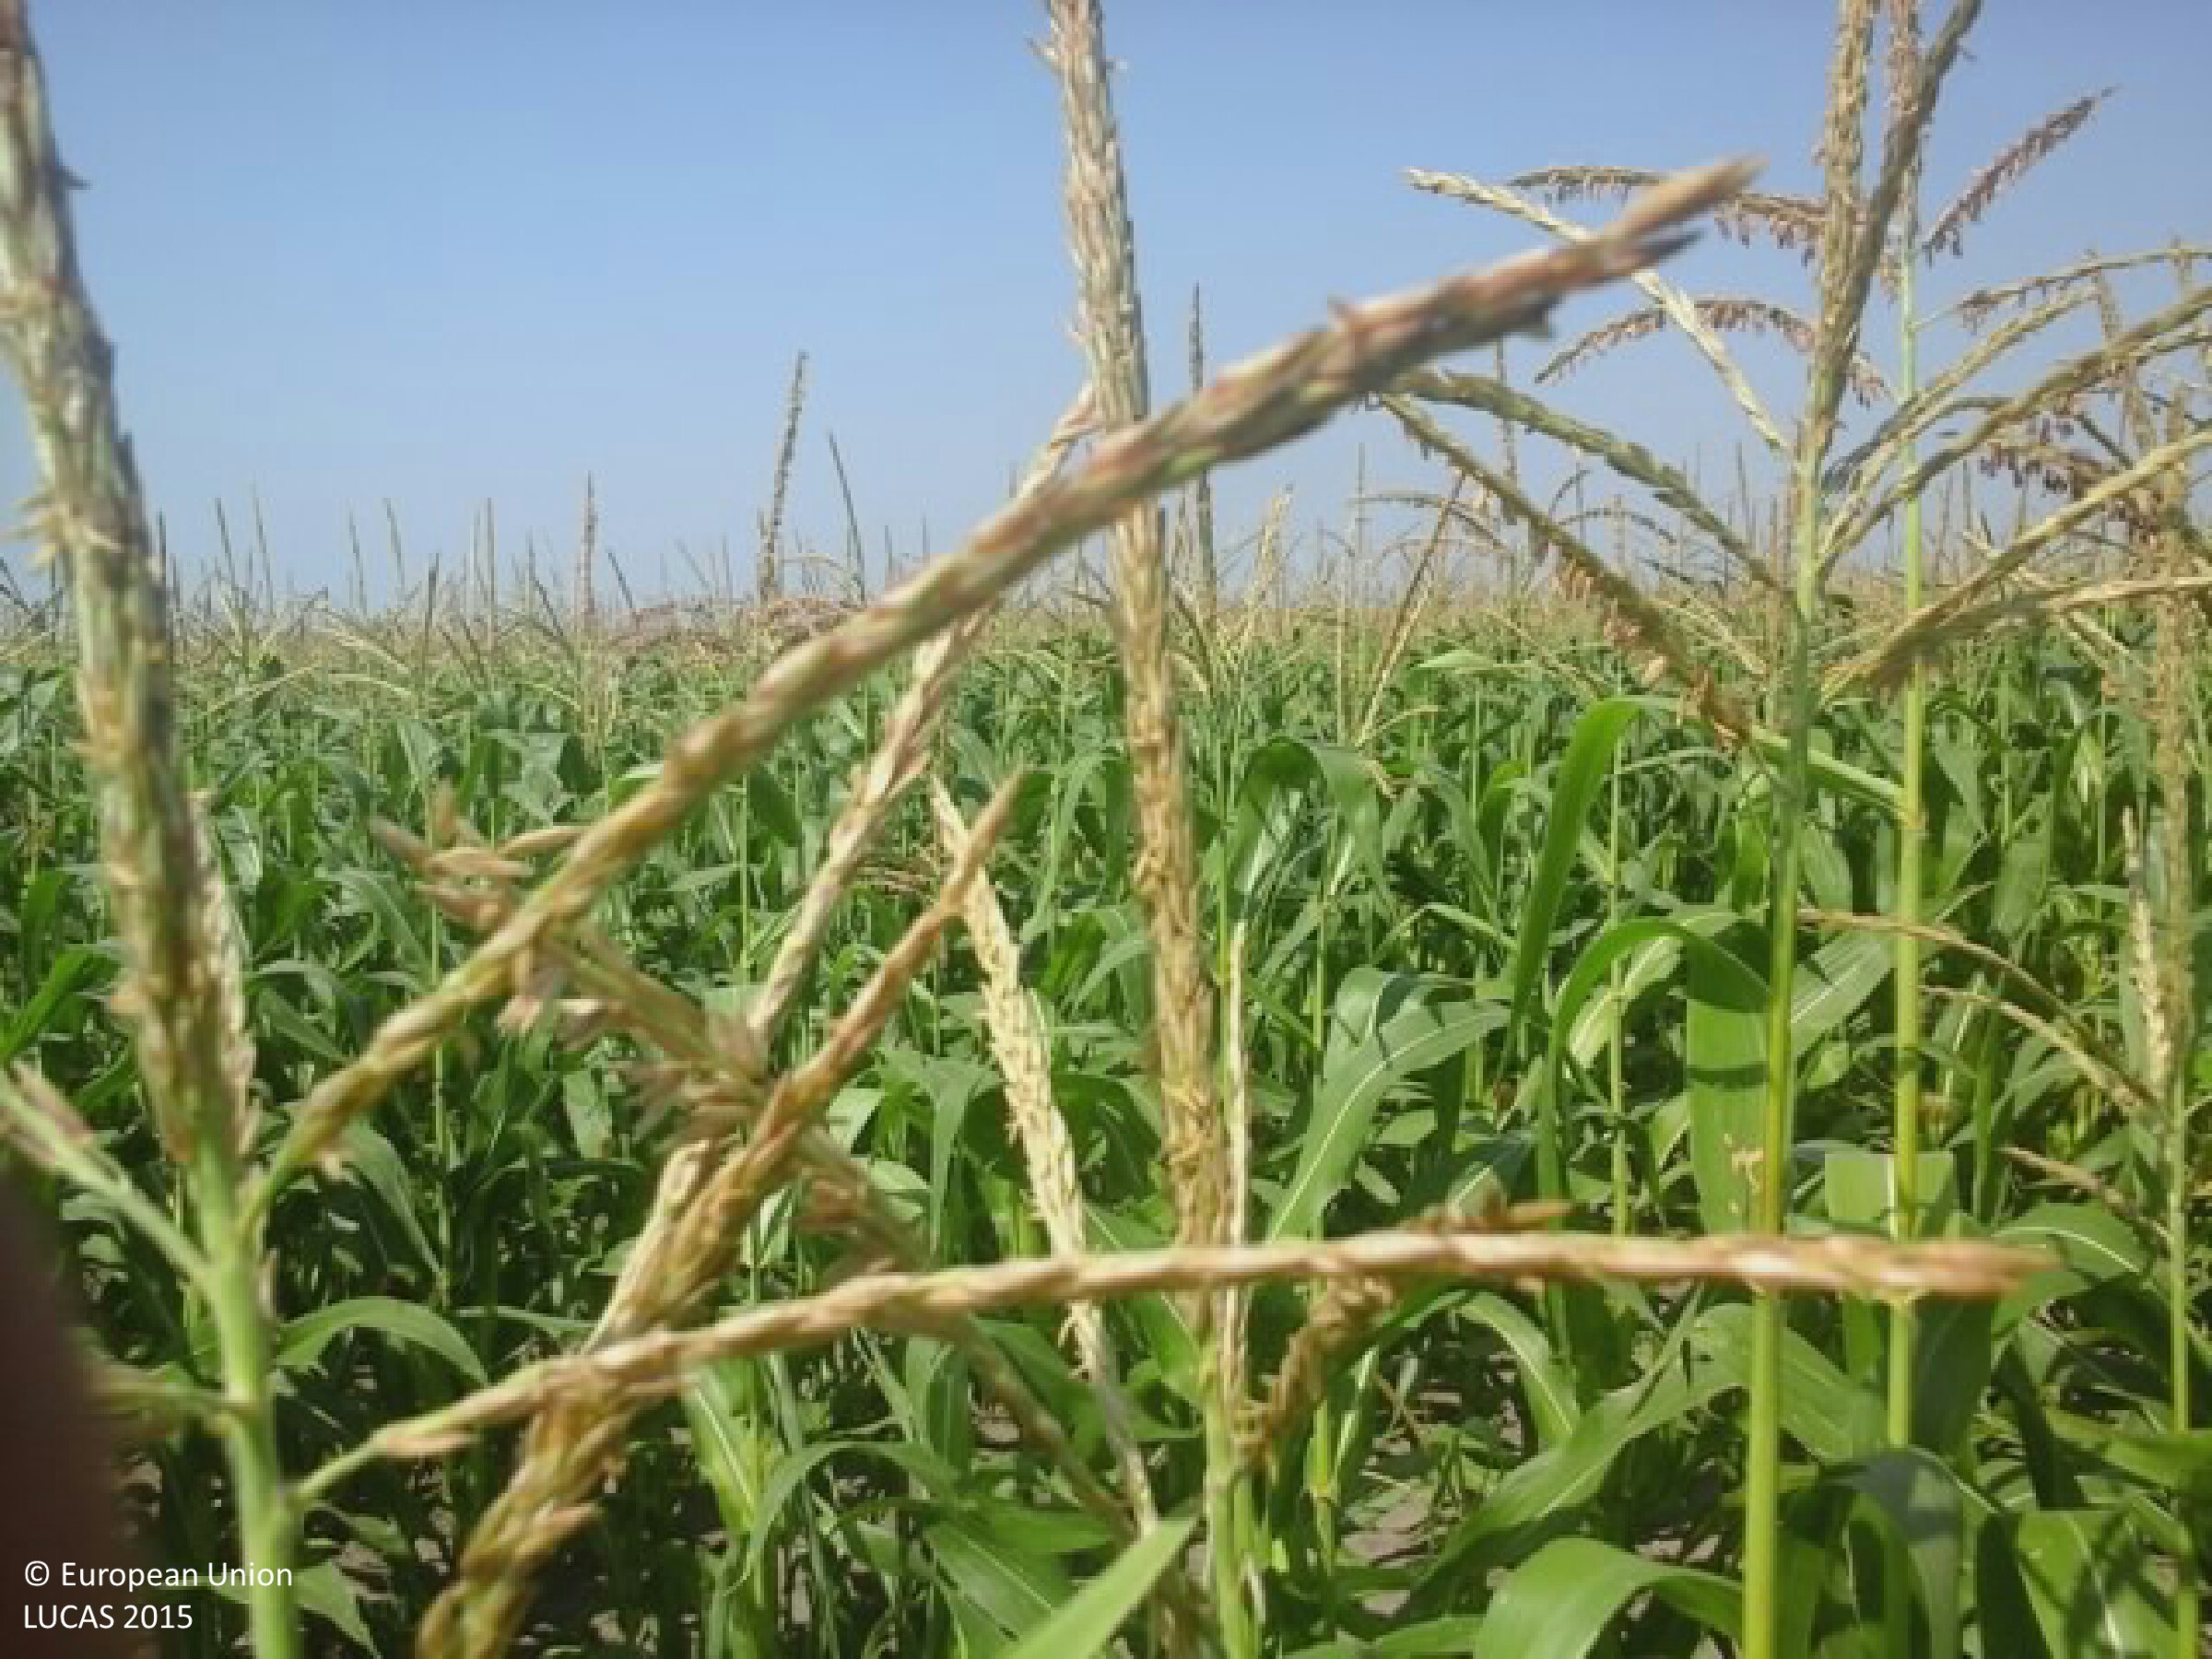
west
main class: Cropland
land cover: Maize
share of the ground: > 75 %
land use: Agriculture (excluding fallow land and kitchen gardens)
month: August
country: HU
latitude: 47.1290
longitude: 19.2326
